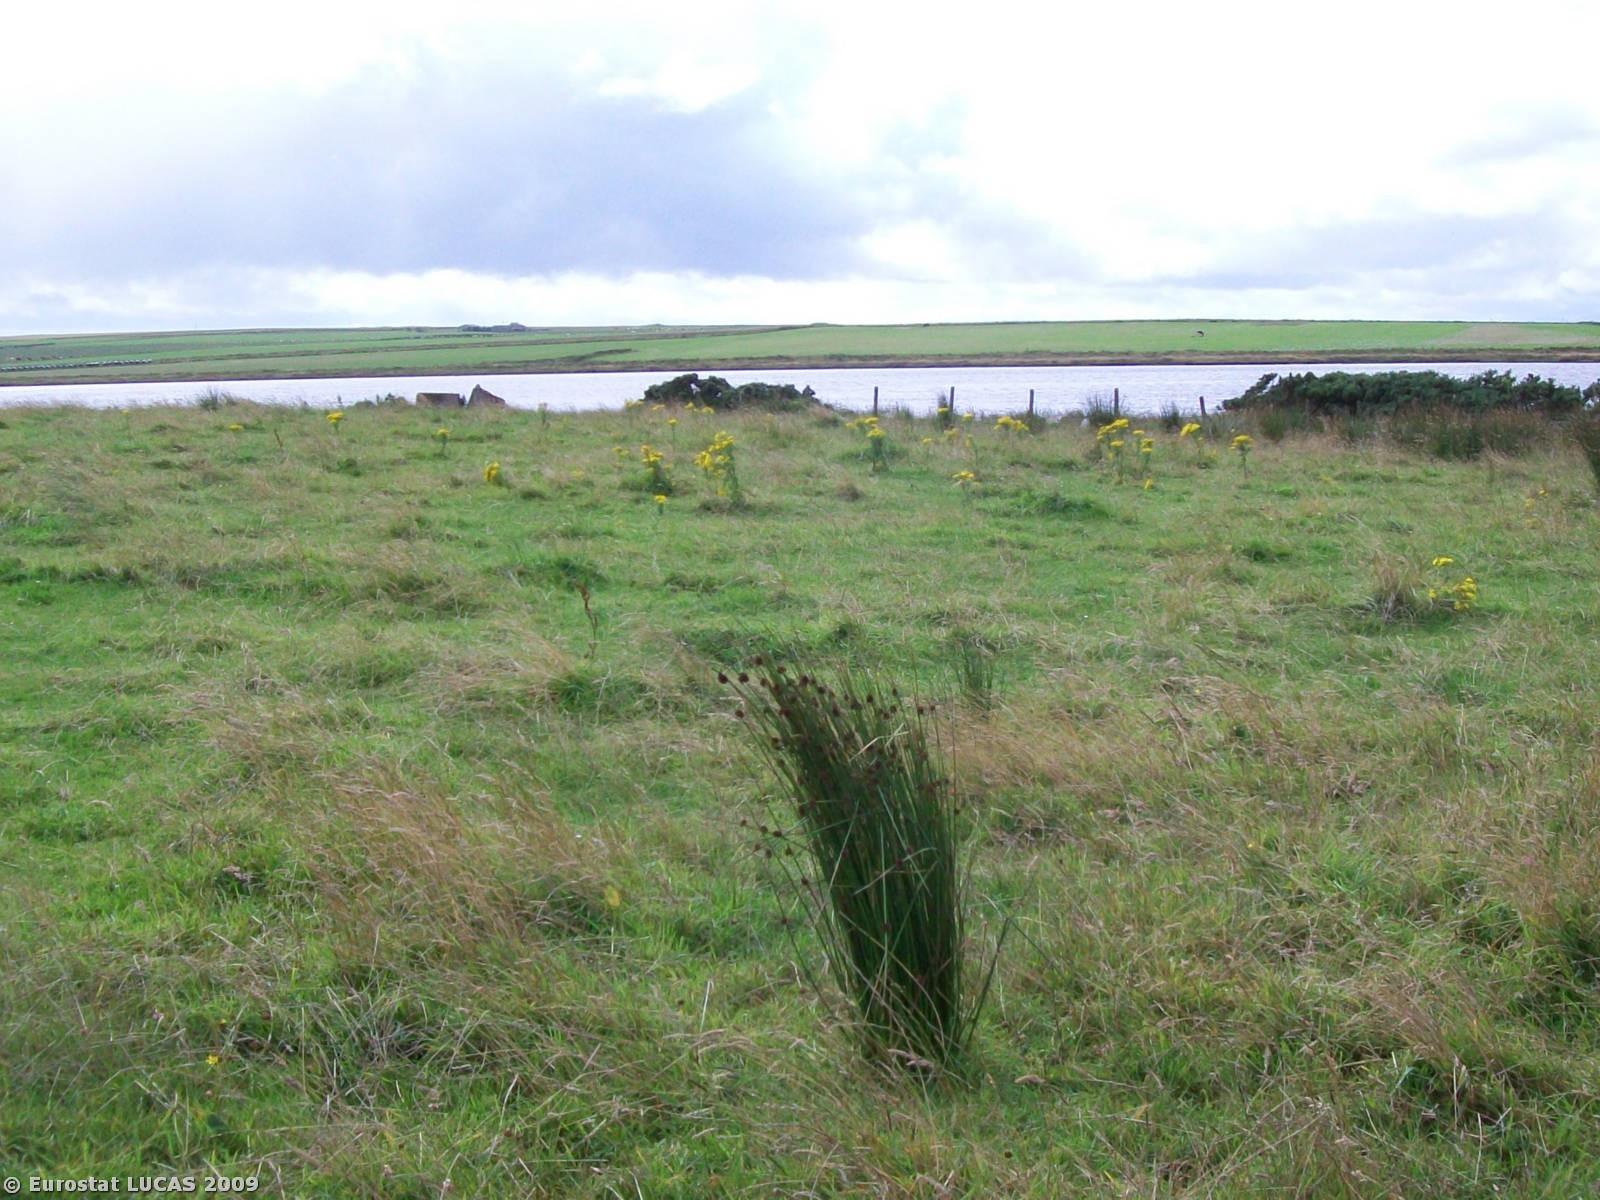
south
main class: Grassland
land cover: Grassland without tree/shrub cover
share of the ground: > 75 %
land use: Agriculture (excluding fallow land and kitchen gardens)
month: August
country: GB
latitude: 58.5188
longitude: -3.1577
